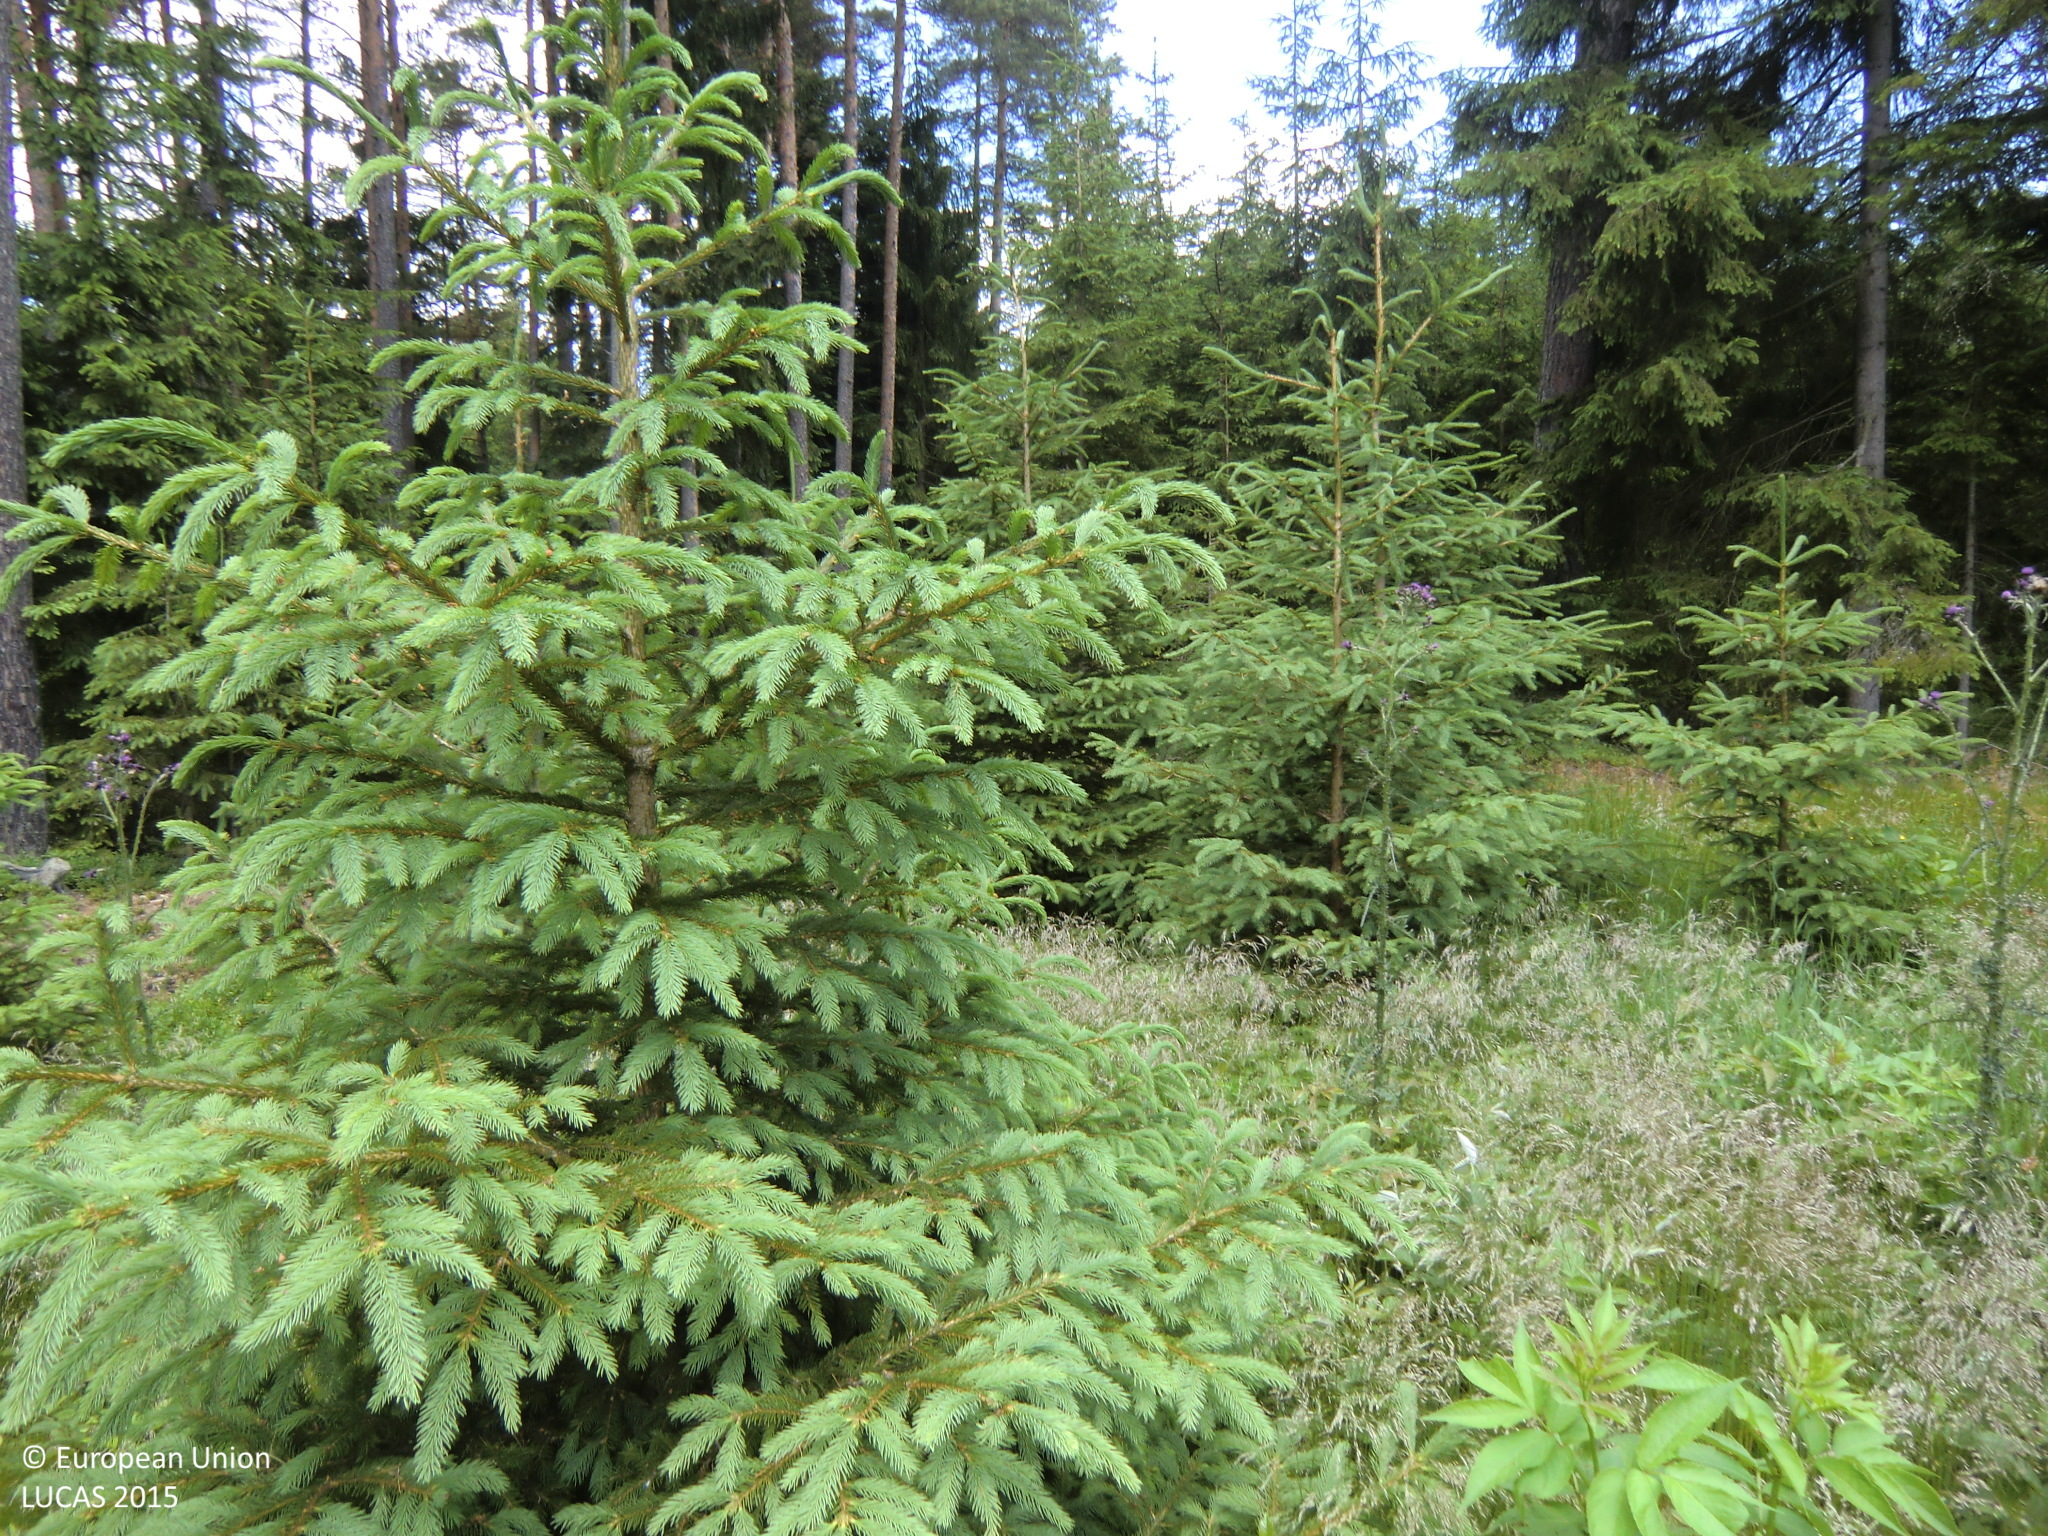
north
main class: Woodland
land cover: Spruce dominated coniferous woodland
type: hemiboreal forest and nemoral coniferous forest and mixed broadleaved-coniferous forest
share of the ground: 25 - 50 %
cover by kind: herbaceous plants 40 %, coniferous forest trees 35 %, shrubs 25 %
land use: Forestry
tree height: < 5 m
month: June
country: AT
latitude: 48.5261
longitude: 14.9710
